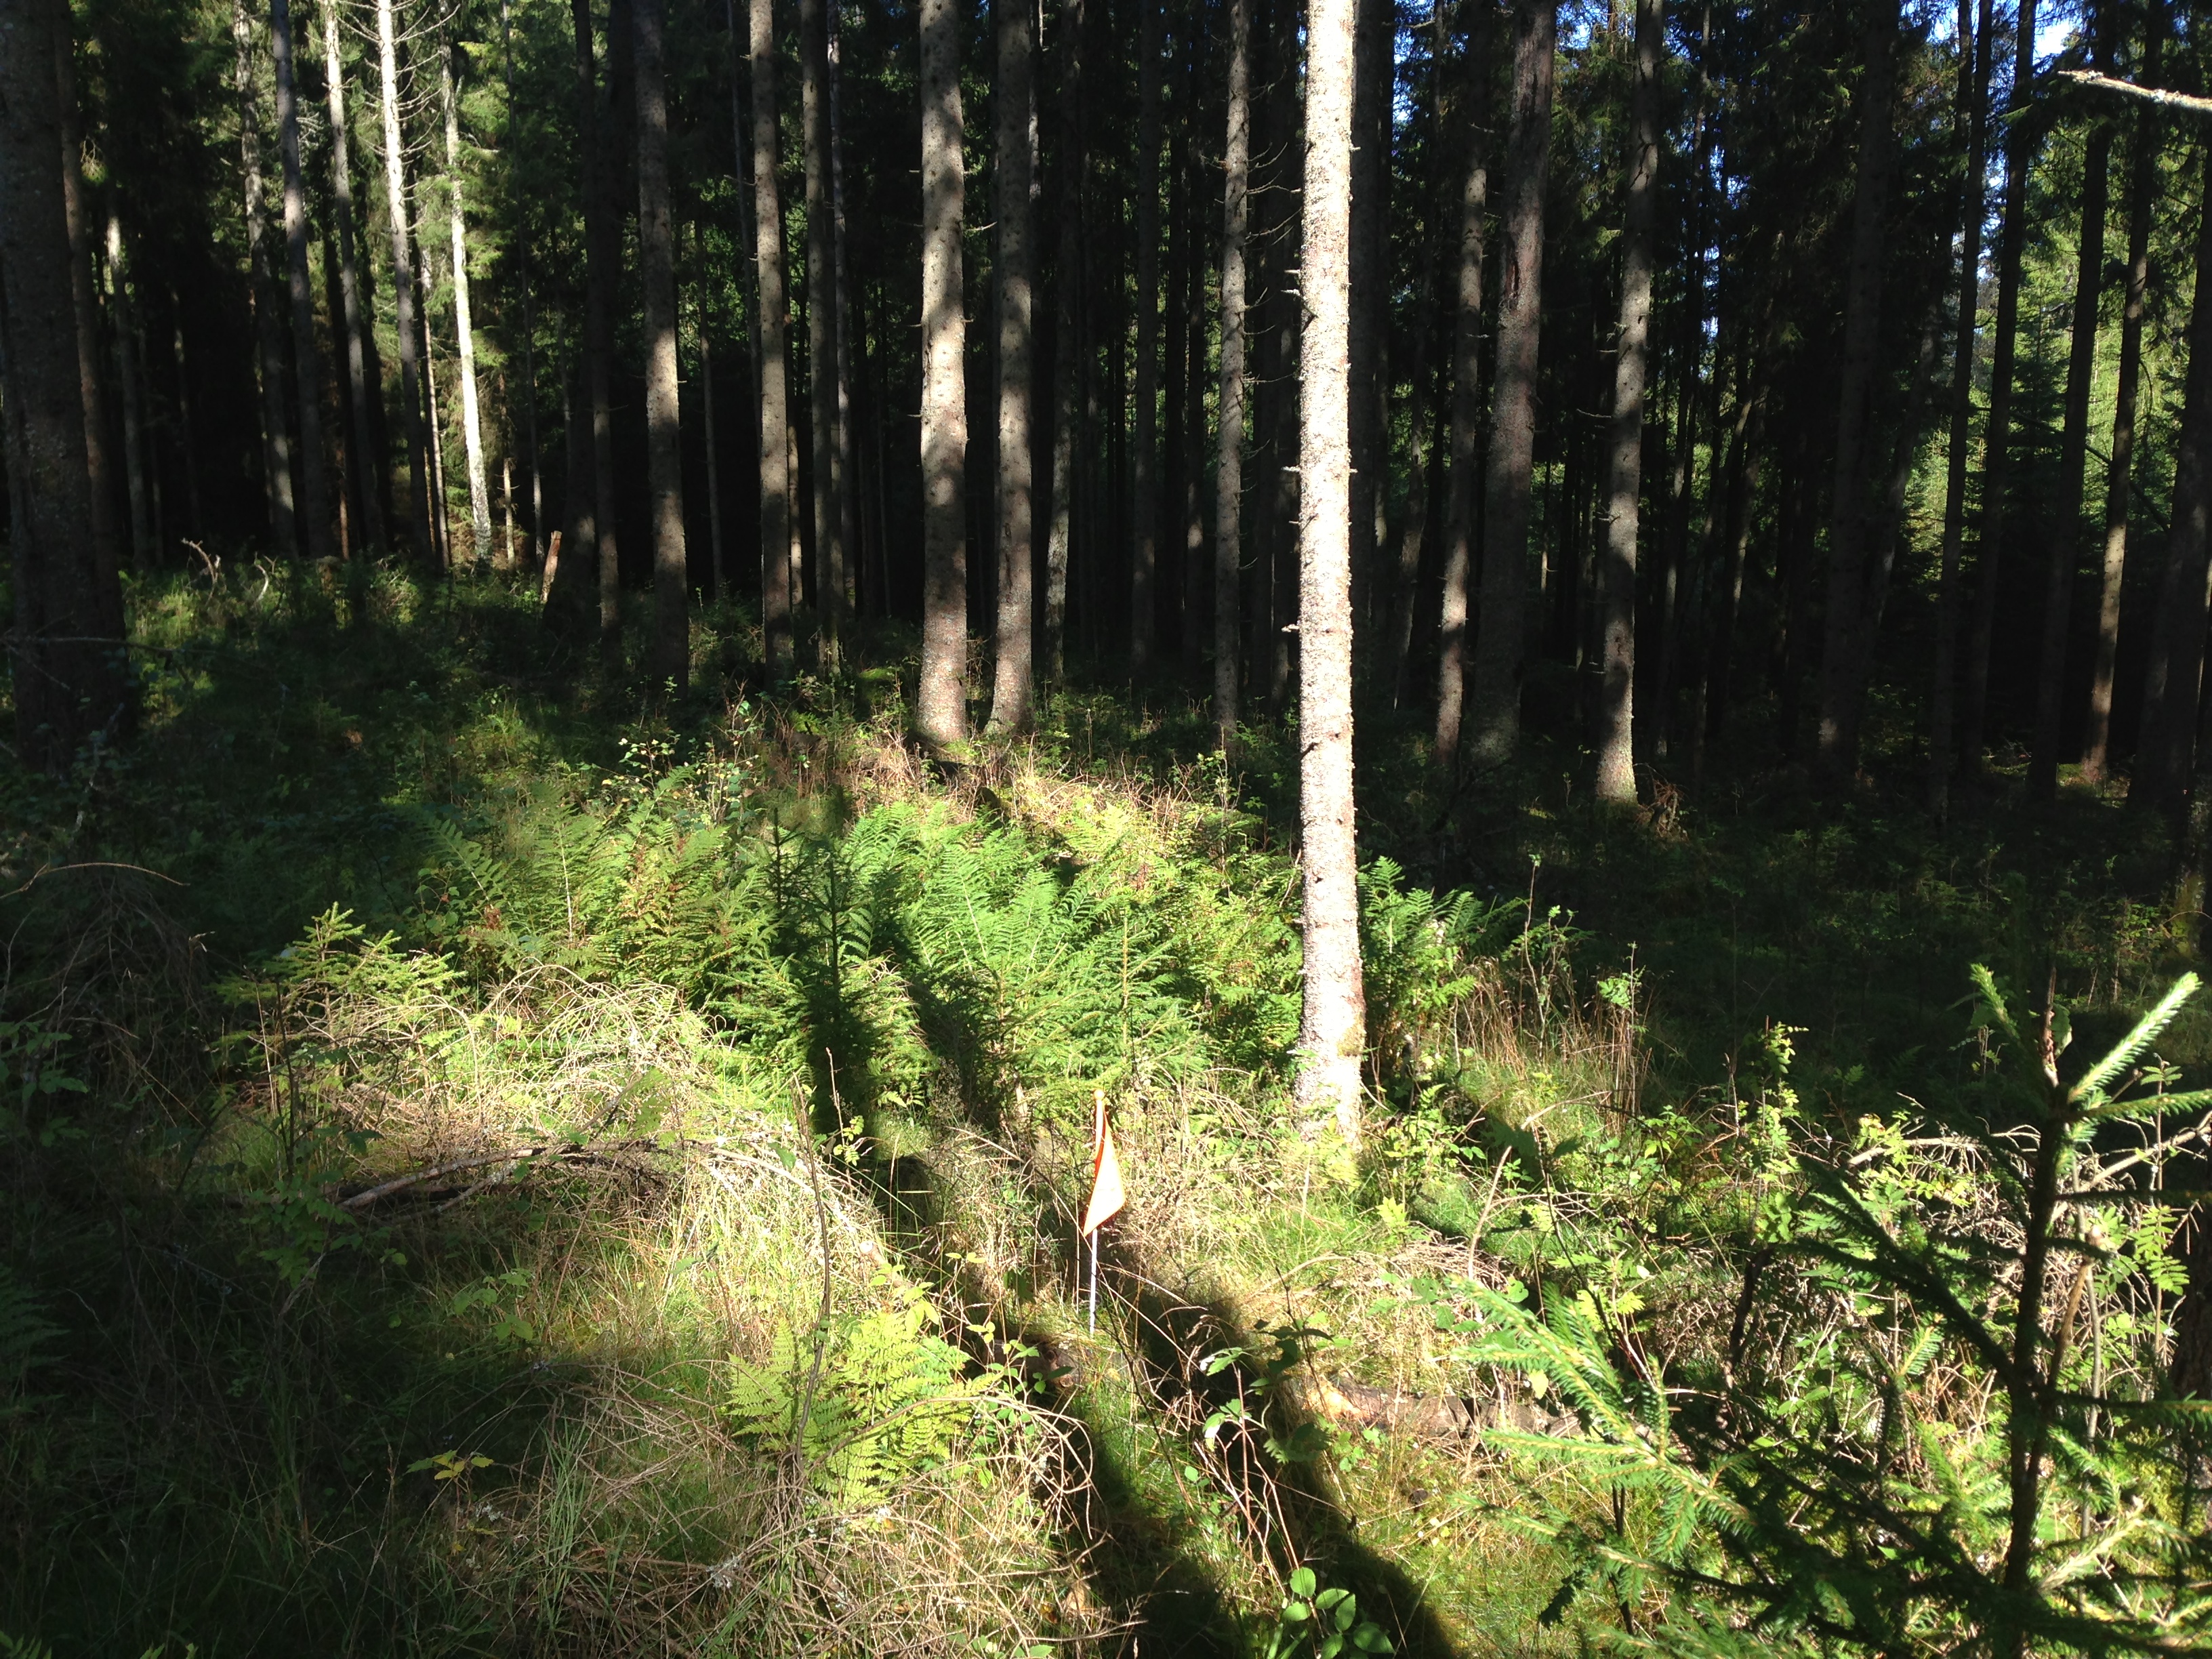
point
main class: Woodland
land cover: Spruce dominated coniferous woodland
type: boreal forest
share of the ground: 50 - 75 %
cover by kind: coniferous forest trees 70 %, shrubs 15 %, herbaceous plants 15 %
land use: Forestry
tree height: > 5 m
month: September
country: SE
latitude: 57.2081
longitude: 13.2575
